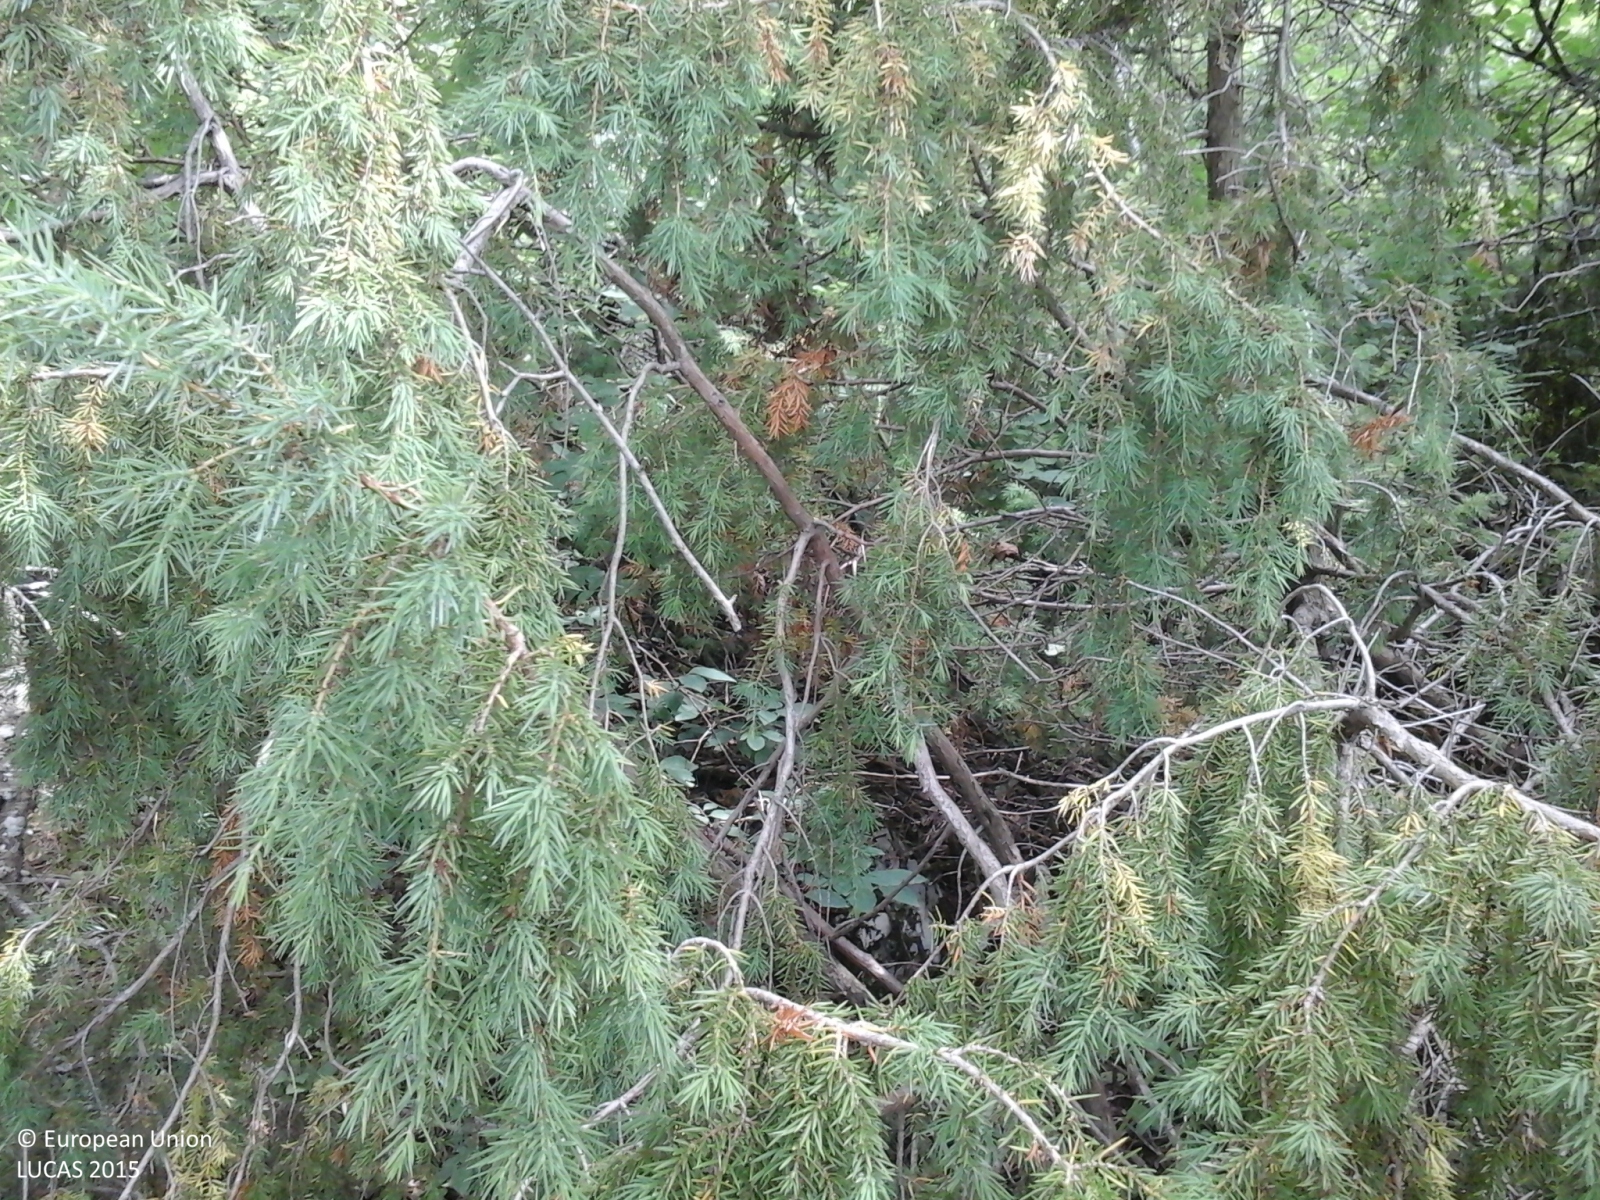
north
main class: Woodland
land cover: Broadleaved woodland
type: mesophytic deciduous forest
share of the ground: > 75 %
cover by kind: broadleaved forest trees 100 %
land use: Semi-natural and natural areas not in use
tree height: > 5 m
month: June
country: IT
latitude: 46.0177
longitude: 12.4123
